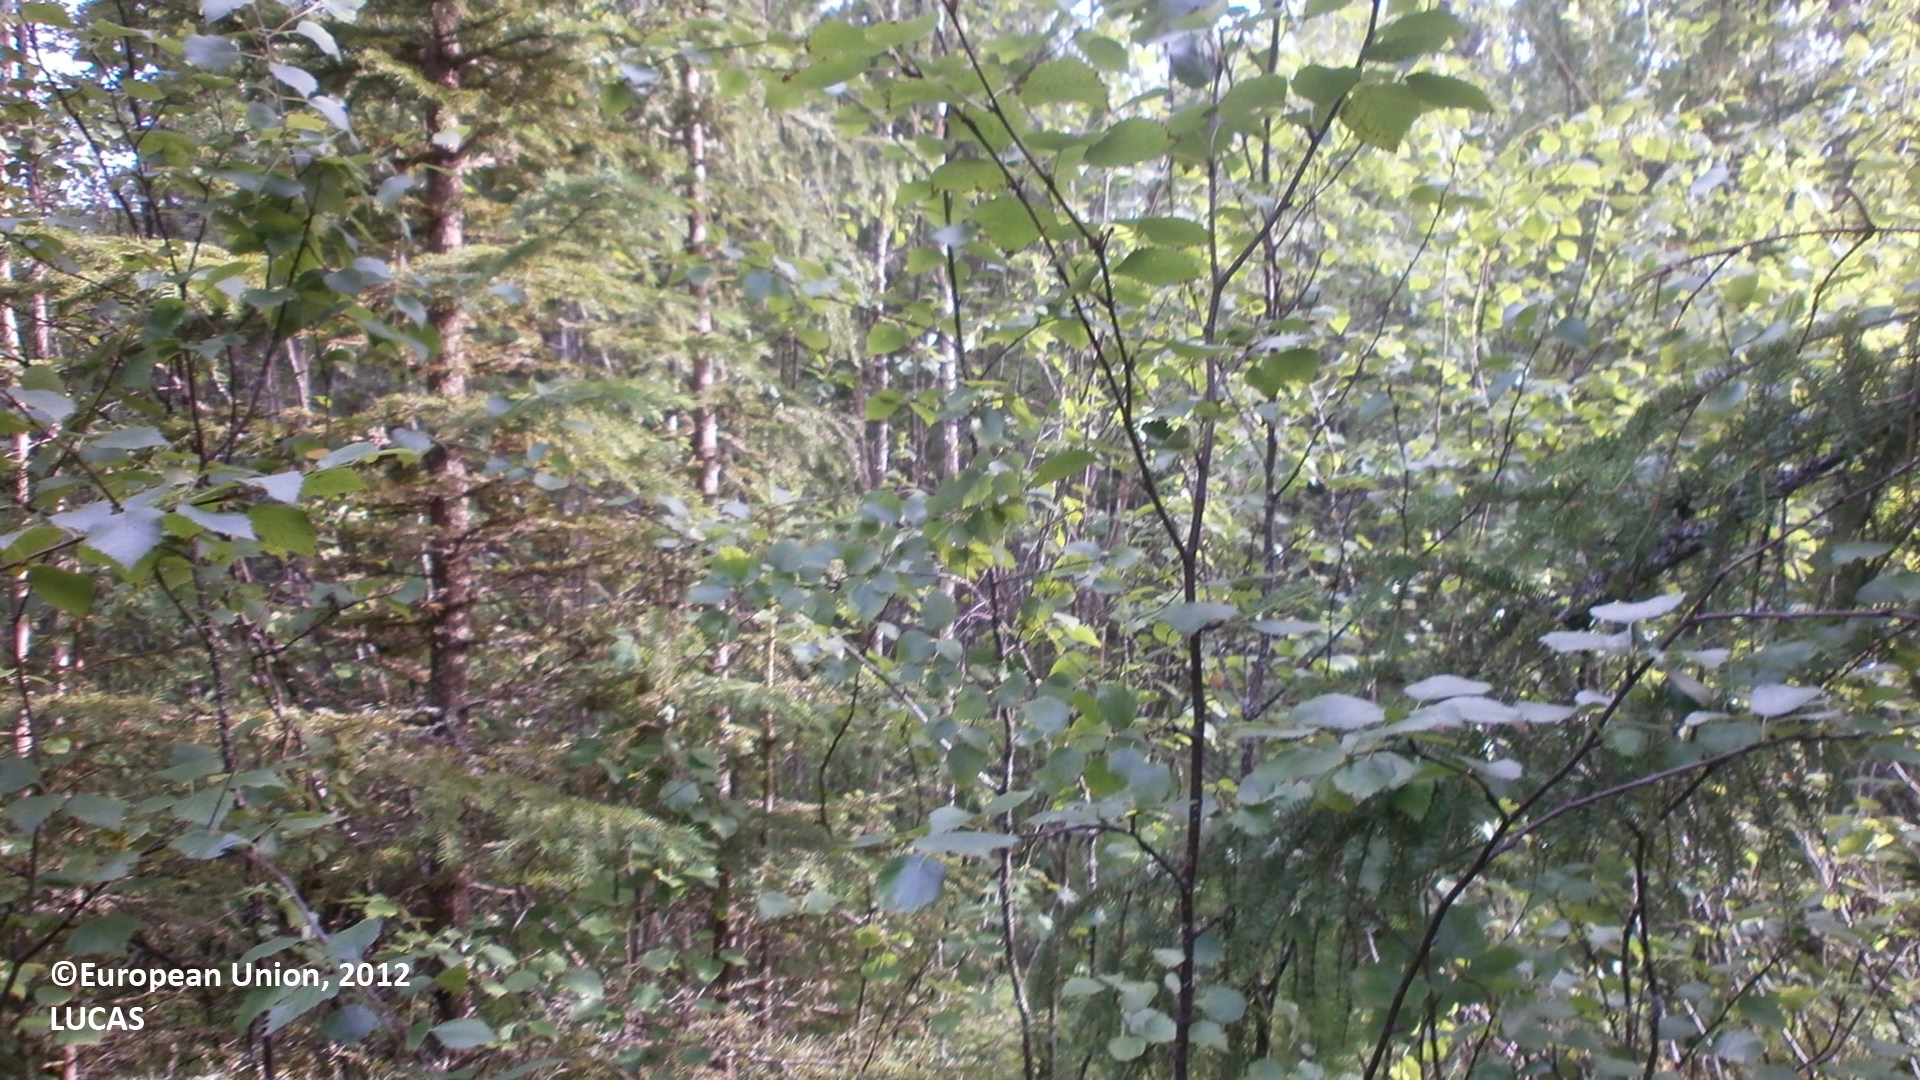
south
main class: Woodland
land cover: Spruce dominated mixed woodland
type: boreal forest
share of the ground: 50 - 75 %
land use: Forestry
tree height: > 5 m
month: July
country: FI
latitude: 64.3369
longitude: 24.2846
